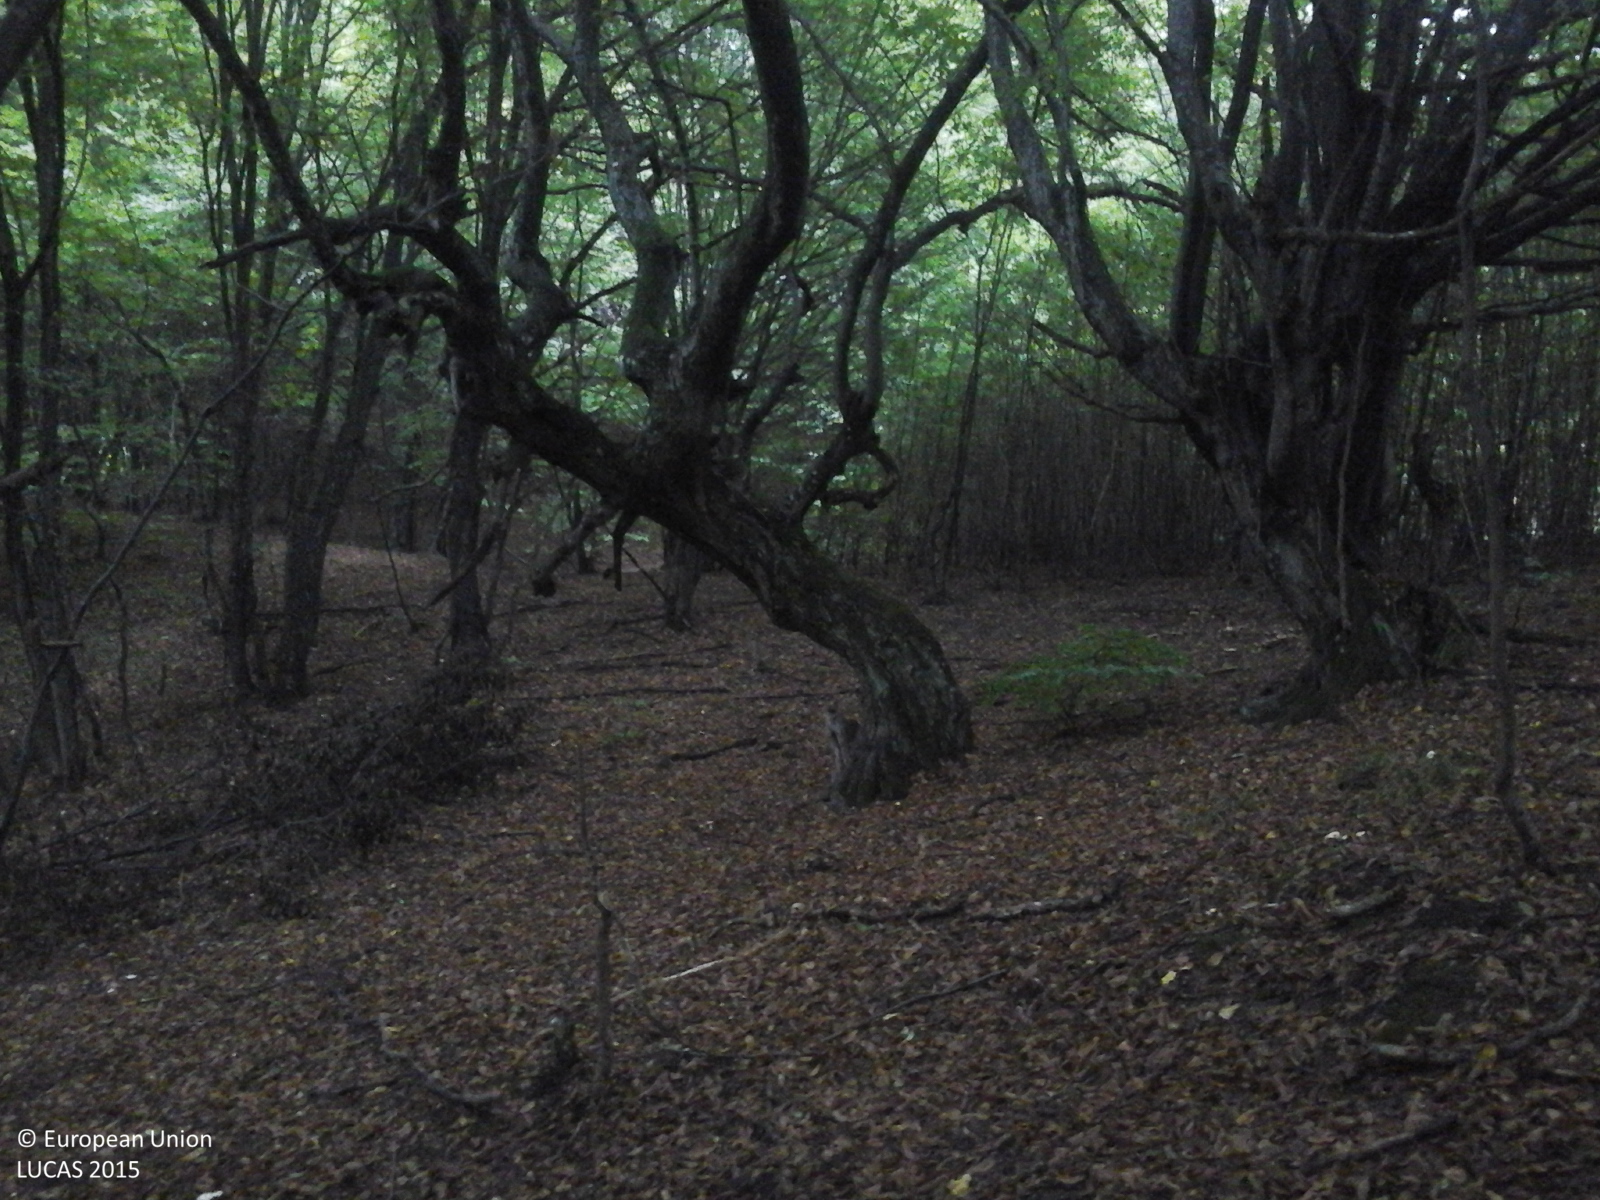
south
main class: Woodland
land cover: Broadleaved woodland
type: mesophytic deciduous forest
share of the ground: > 75 %
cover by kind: broadleaved forest trees 100 %
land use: Forestry
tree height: > 5 m
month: October
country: RO
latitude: 46.2516
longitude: 23.5441
